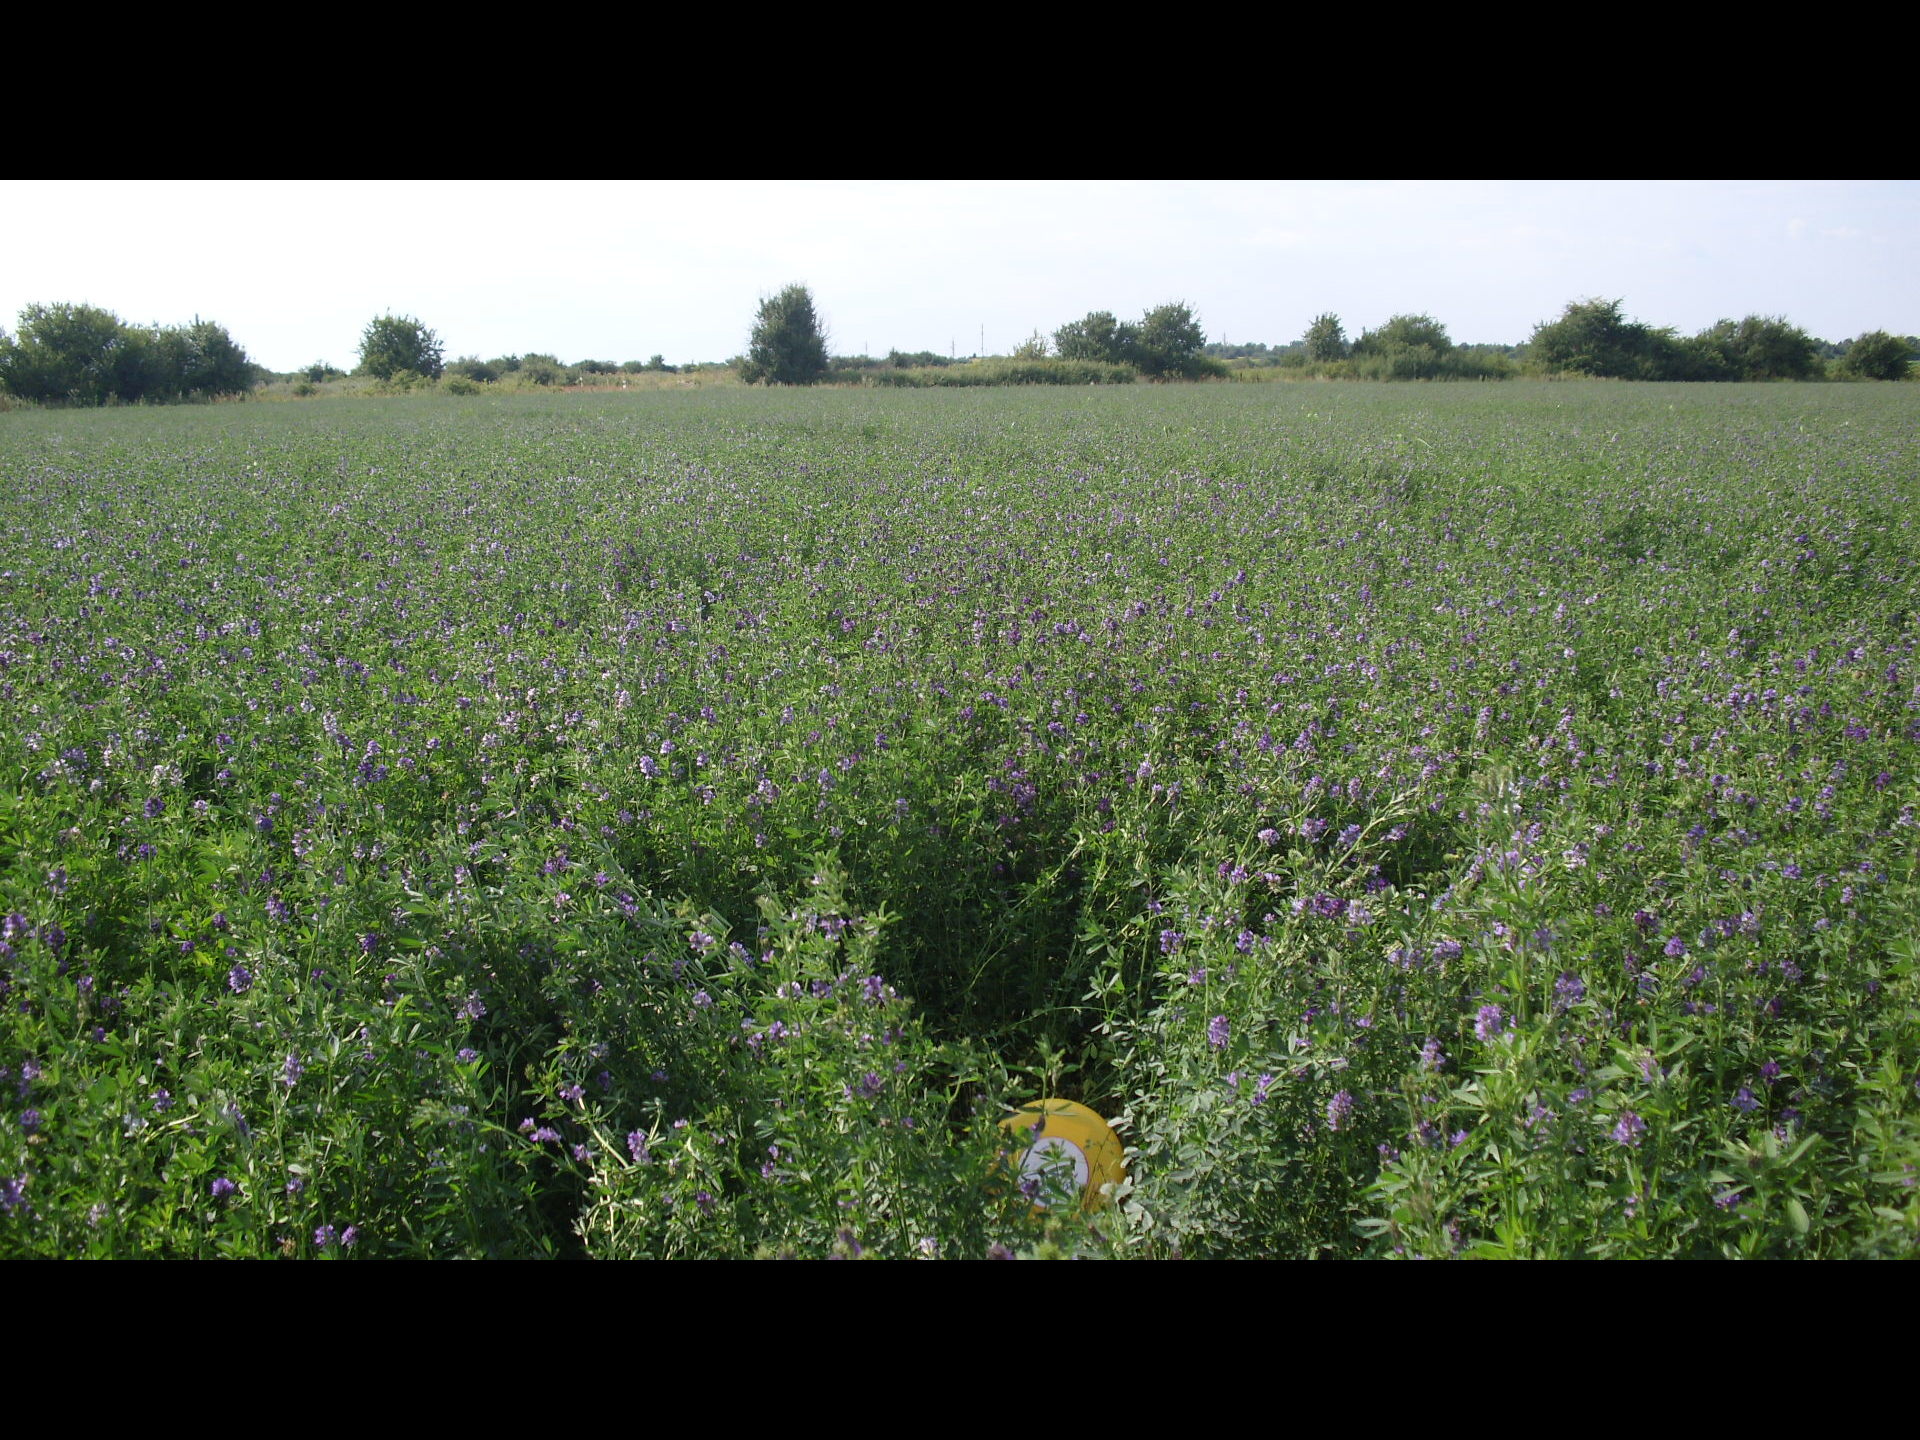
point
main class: Cropland
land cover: Lucerne
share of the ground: > 75 %
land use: Agriculture (excluding fallow land and kitchen gardens)
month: July
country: BG
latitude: 43.7458
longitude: 23.0163
